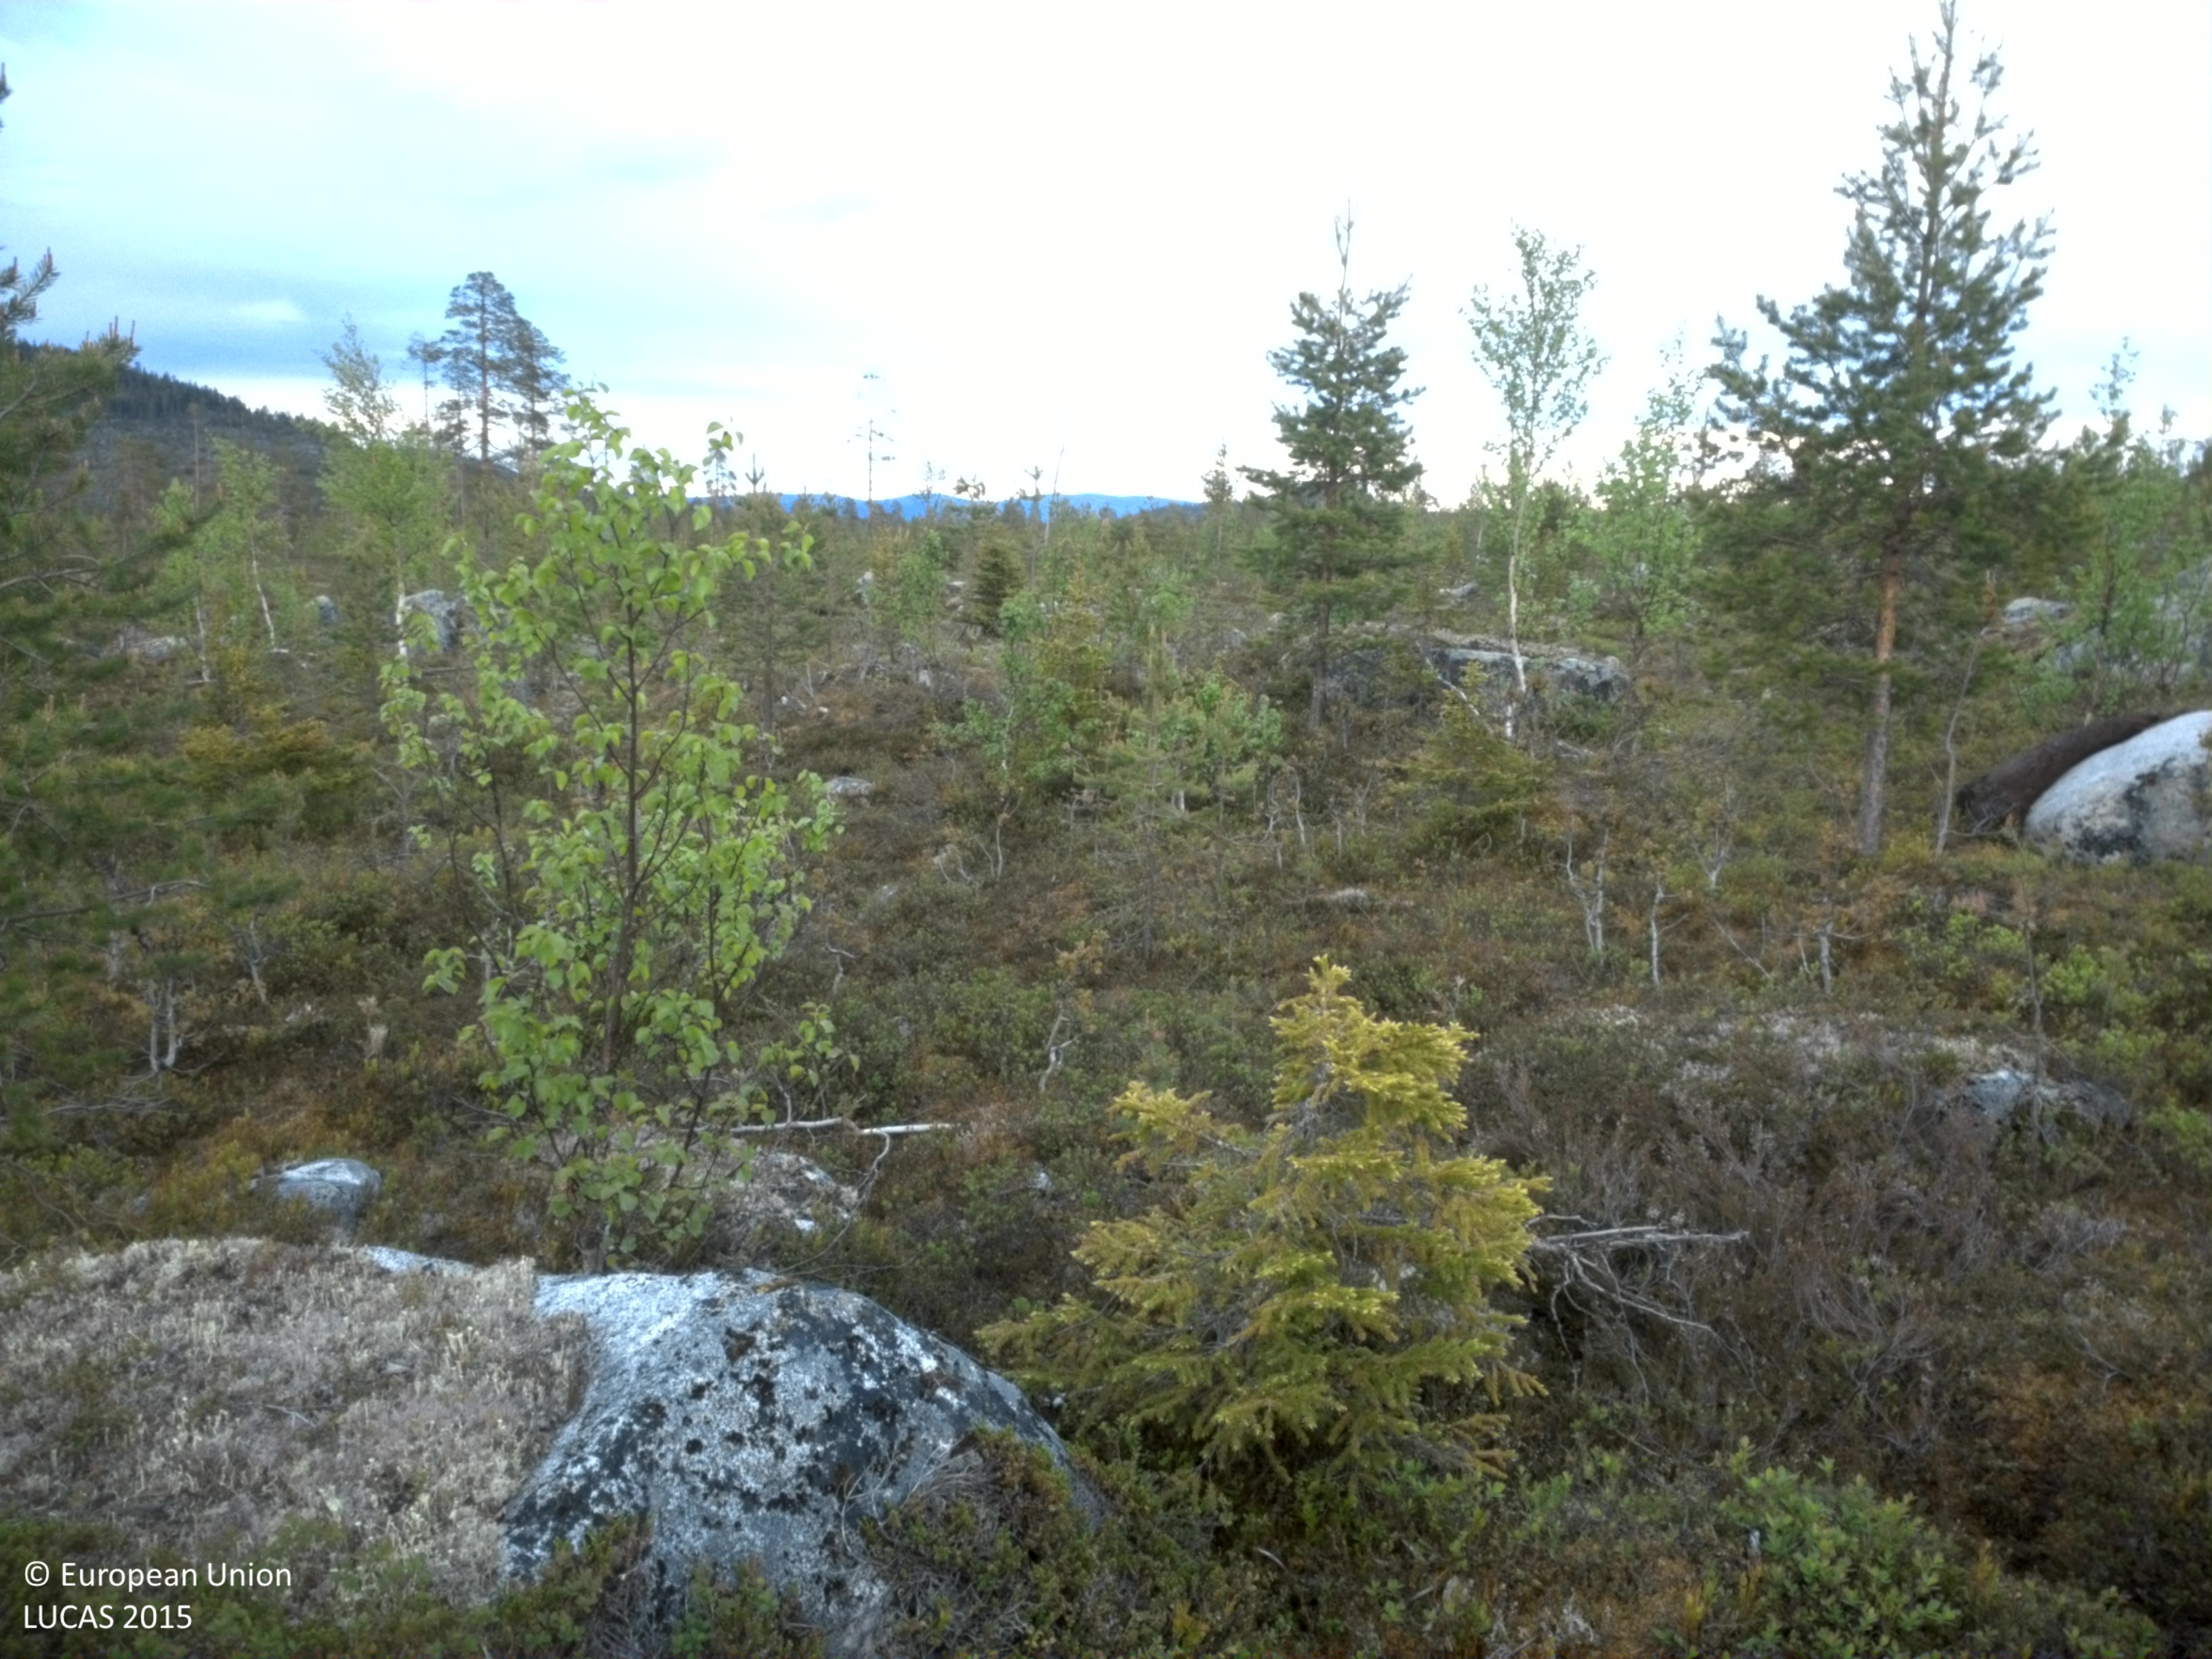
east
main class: Woodland
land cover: Pine dominated coniferous woodland
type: boreal forest
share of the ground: 10 - 25 %
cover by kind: shrubs 70 %, coniferous forest trees 20 %, broadleaved forest trees 5 %, consolidated bare surface 5 %
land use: Forestry
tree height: < 5 m
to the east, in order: Pine dominated coniferous woodland; Pine dominated mixed woodland
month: June
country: SE
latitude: 65.9910
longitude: 19.8041
